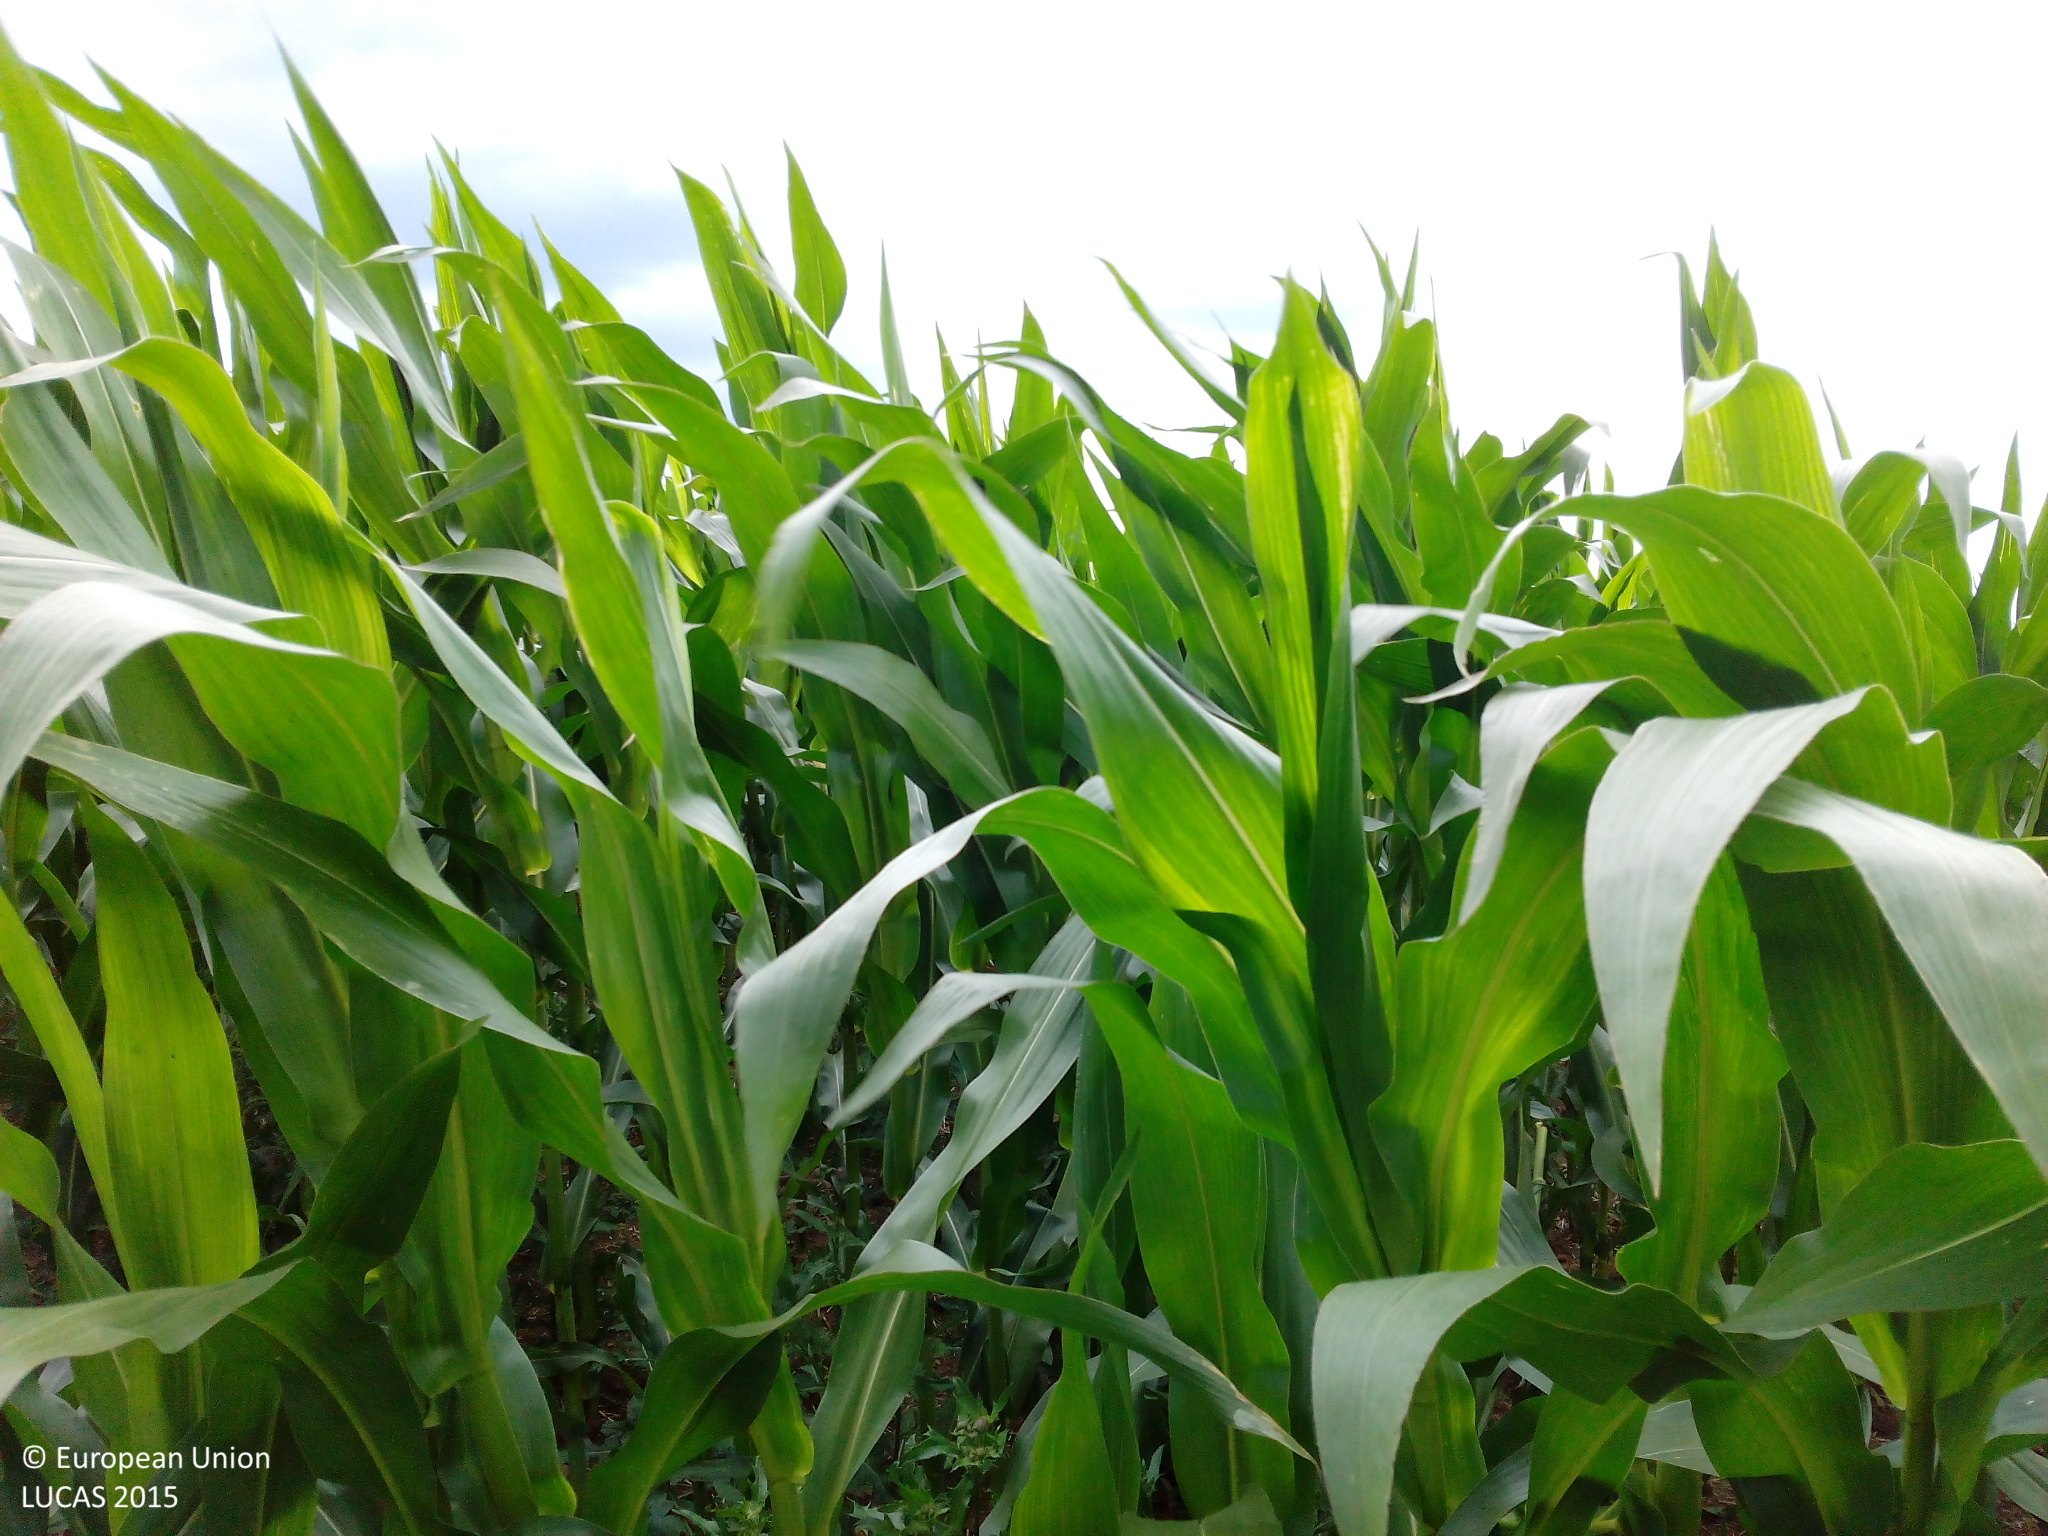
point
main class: Cropland
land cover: Maize
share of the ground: > 75 %
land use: Agriculture (excluding fallow land and kitchen gardens)
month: July
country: DE
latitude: 49.8159
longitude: 12.4596
